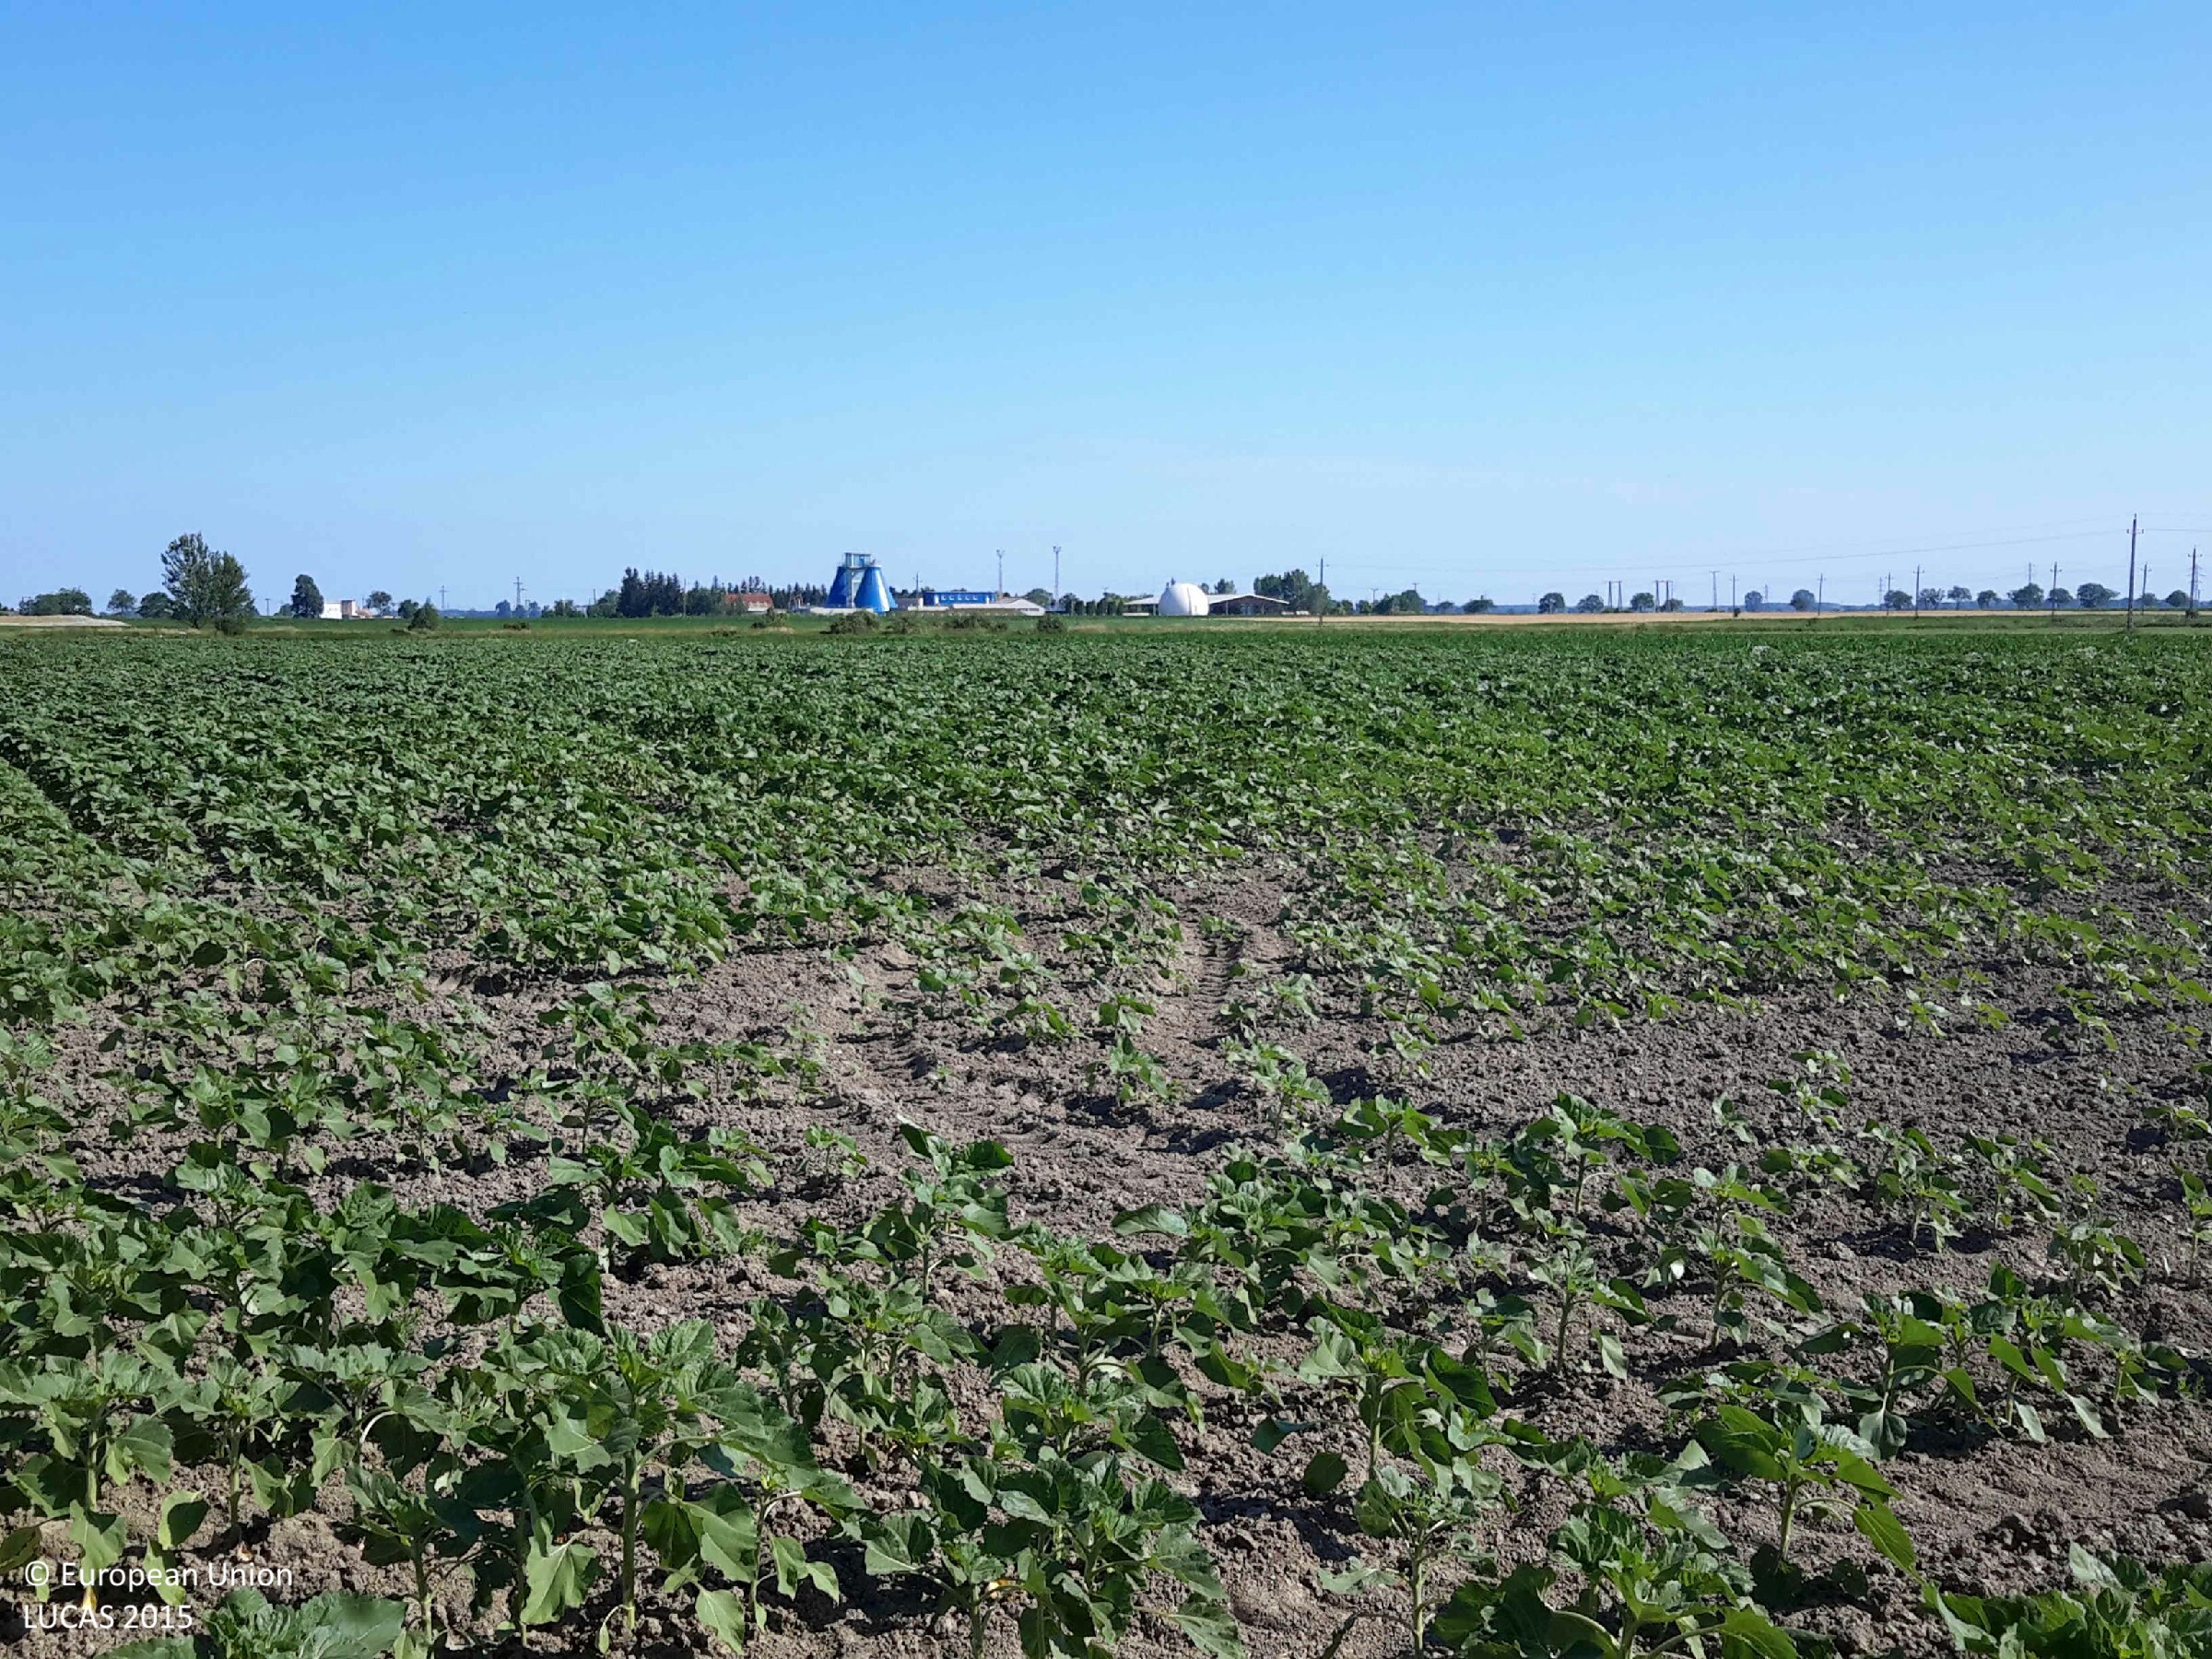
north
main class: Cropland
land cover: Sunflower
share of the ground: > 75 %
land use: Agriculture (excluding fallow land and kitchen gardens)
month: June
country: HU
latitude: 47.6008
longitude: 17.0422
